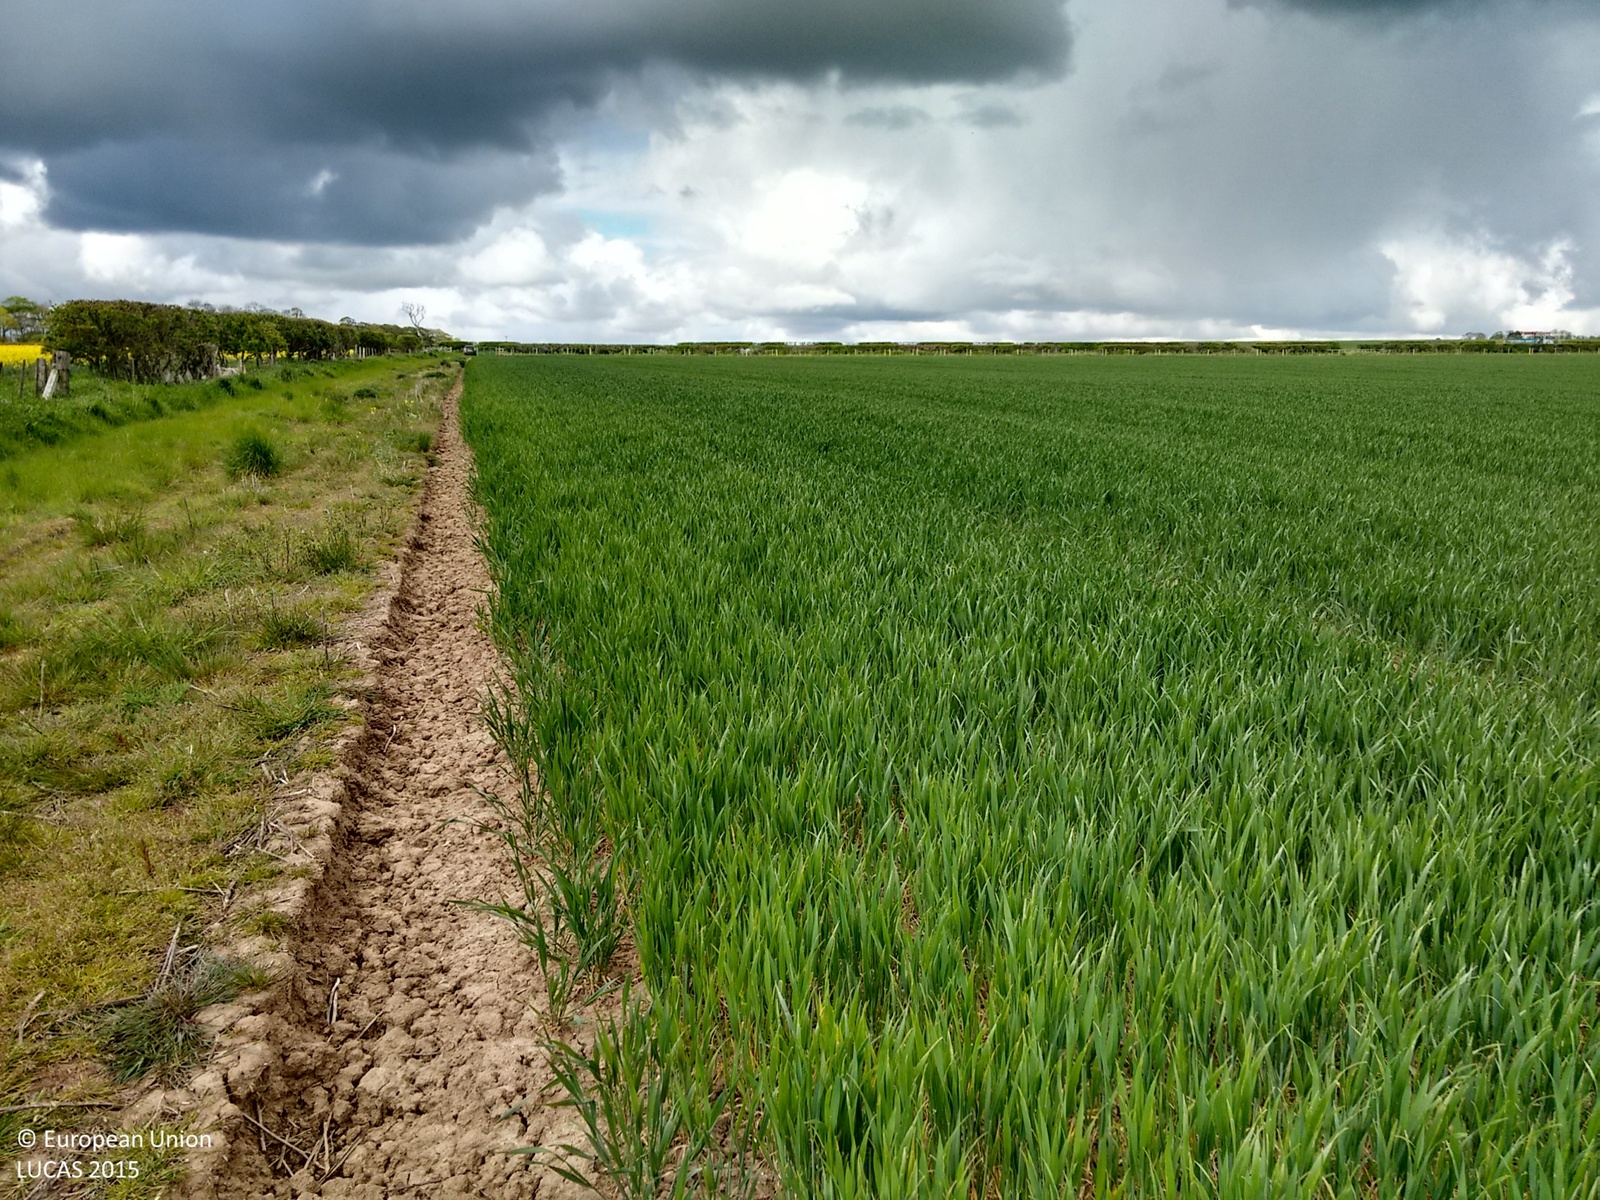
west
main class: Cropland
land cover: Common wheat
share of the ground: > 75 %
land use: Agriculture (excluding fallow land and kitchen gardens)
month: May
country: GB
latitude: 55.3675
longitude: -1.6128
